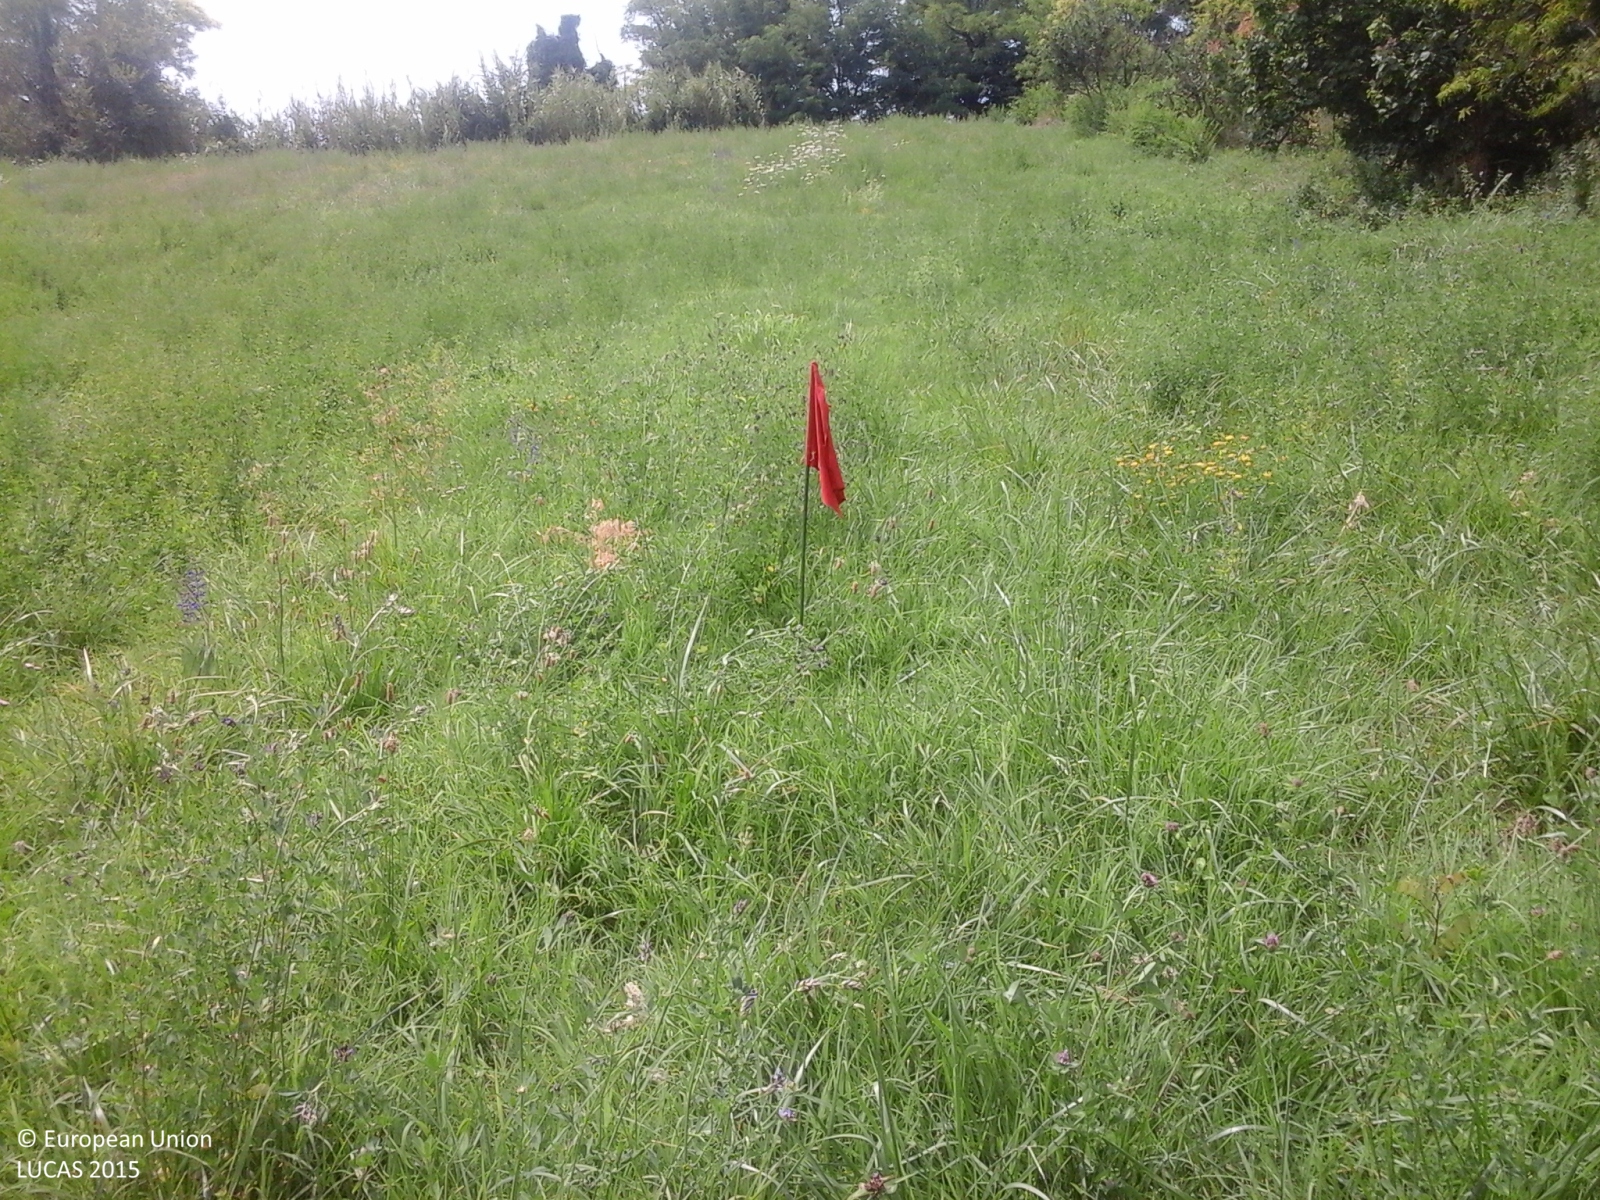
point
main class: Grassland
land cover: Grassland without tree/shrub cover
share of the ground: > 75 %
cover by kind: herbaceous plants 100 %
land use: Agriculture (excluding fallow land and kitchen gardens)
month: June
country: IT
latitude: 44.9900
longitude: 8.5695
